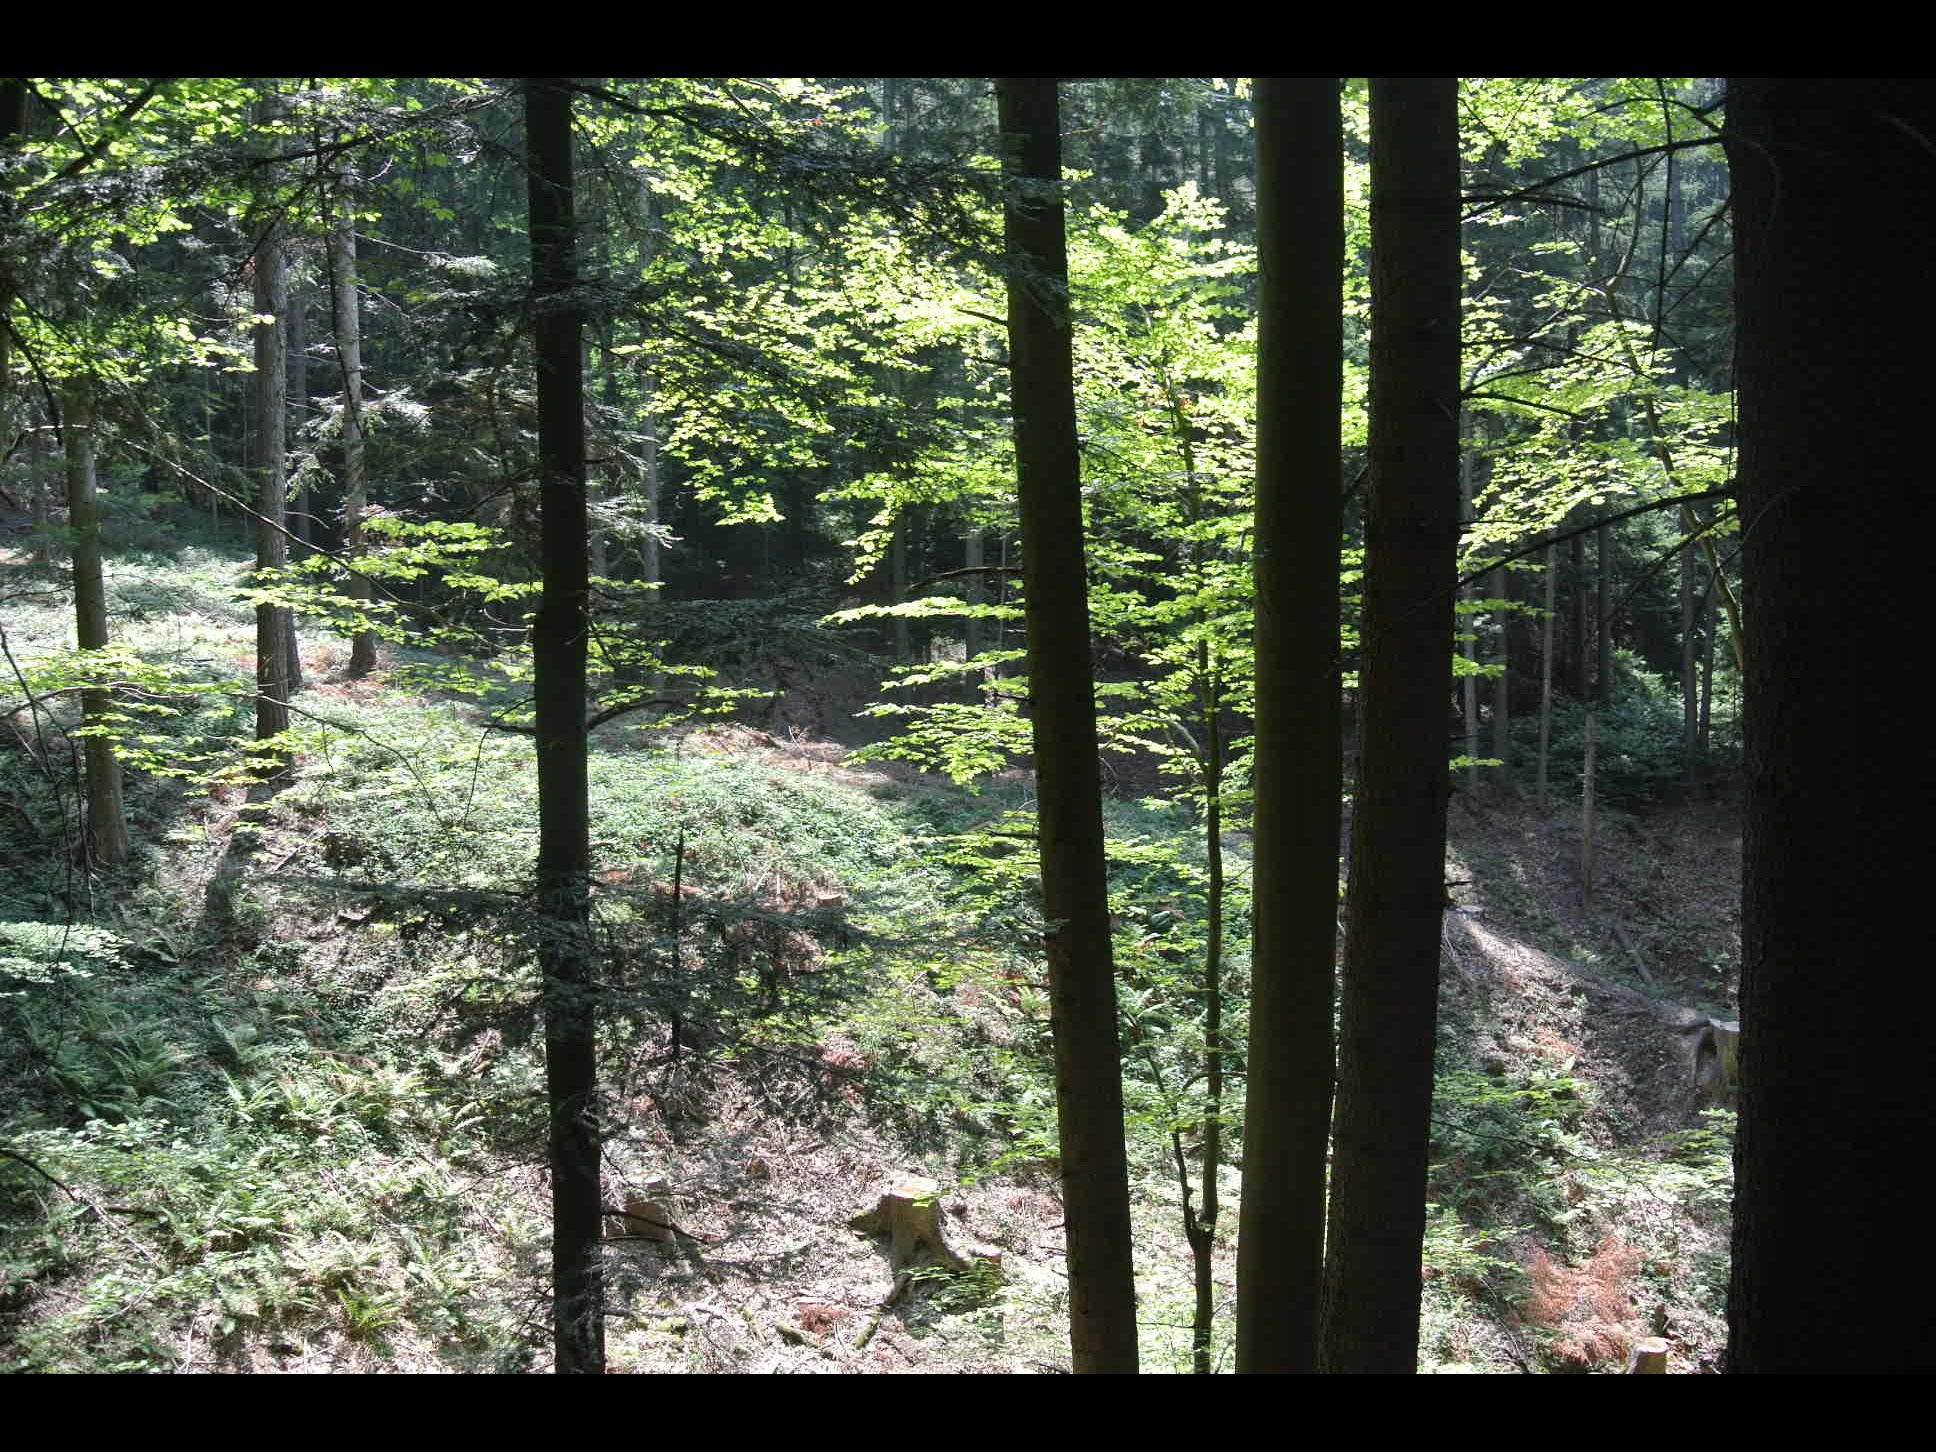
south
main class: Woodland
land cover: Other mixed woodland
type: alpine coniferous forest
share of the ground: > 75 %
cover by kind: coniferous forest trees 60 %, broadleaved forest trees 35 %, herbaceous plants 5 %
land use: Forestry
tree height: > 5 m
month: July
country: AT
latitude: 47.6344
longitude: 16.1918
